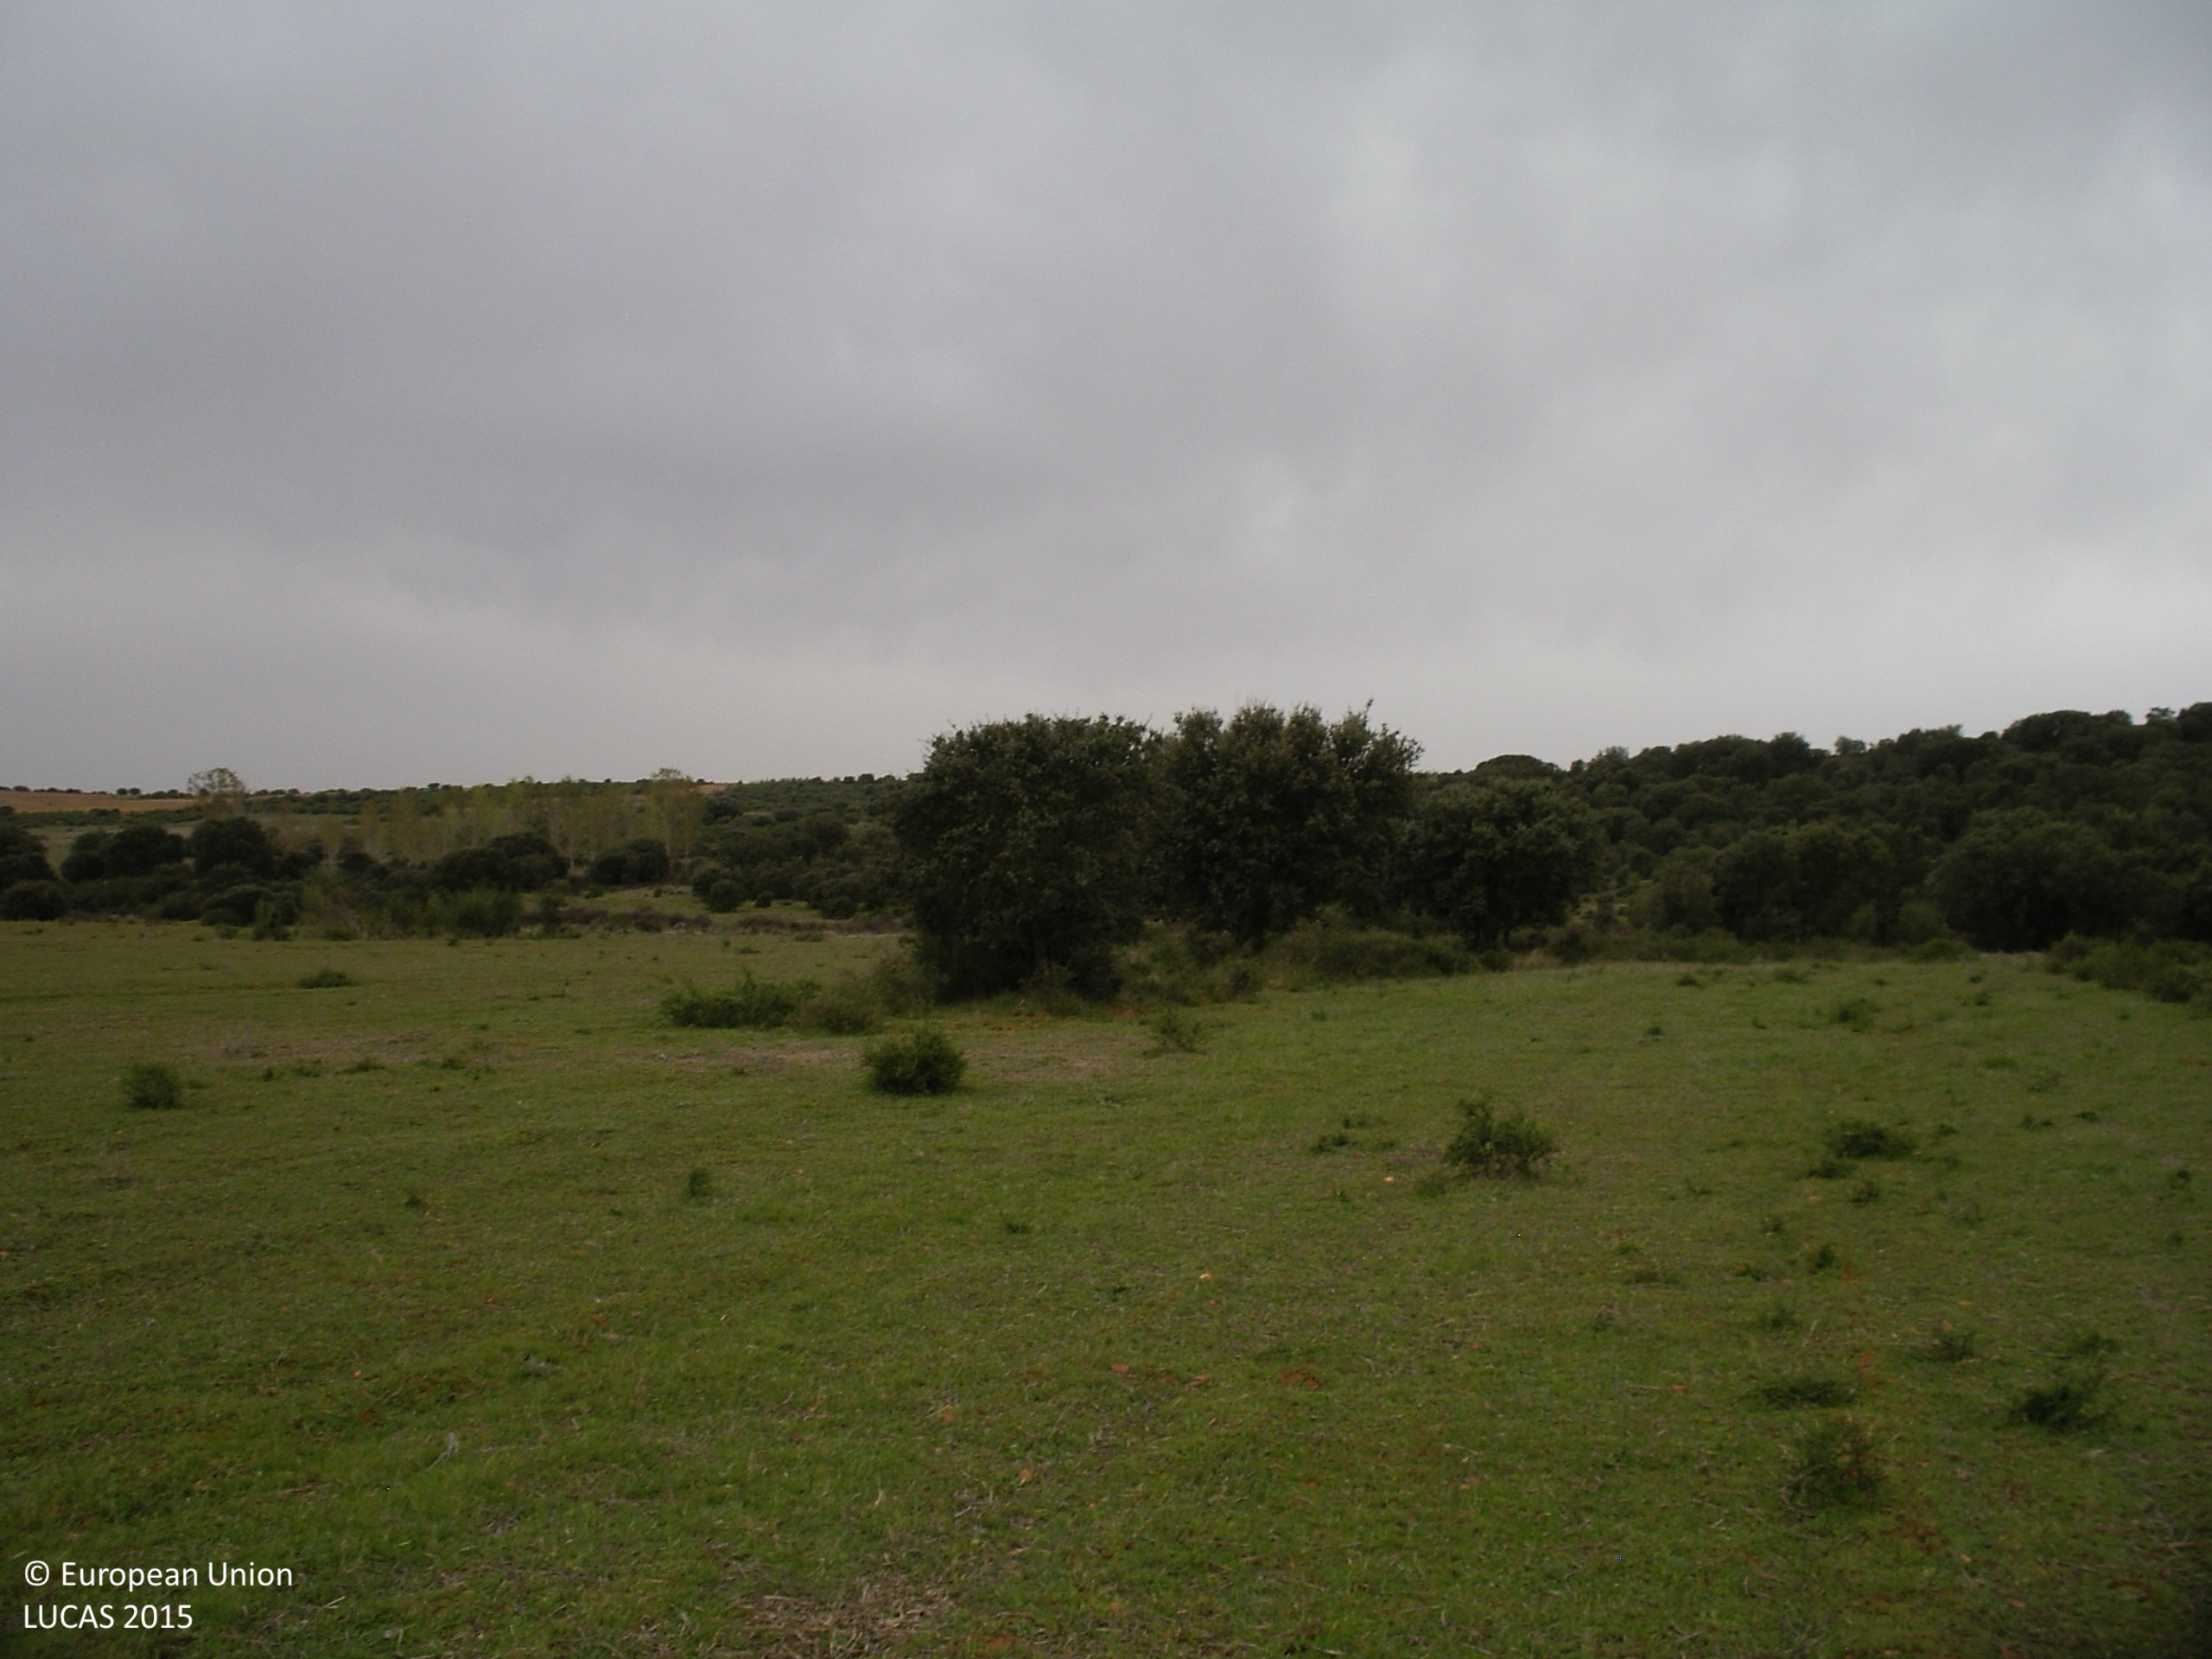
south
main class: Grassland
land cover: Spontaneously vegetated surfaces
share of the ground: > 75 %
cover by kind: herbaceous plants 95 %, shrubs 5 %
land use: Agriculture (excluding fallow land and kitchen gardens)
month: April
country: ES
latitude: 42.4553
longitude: -6.1218
